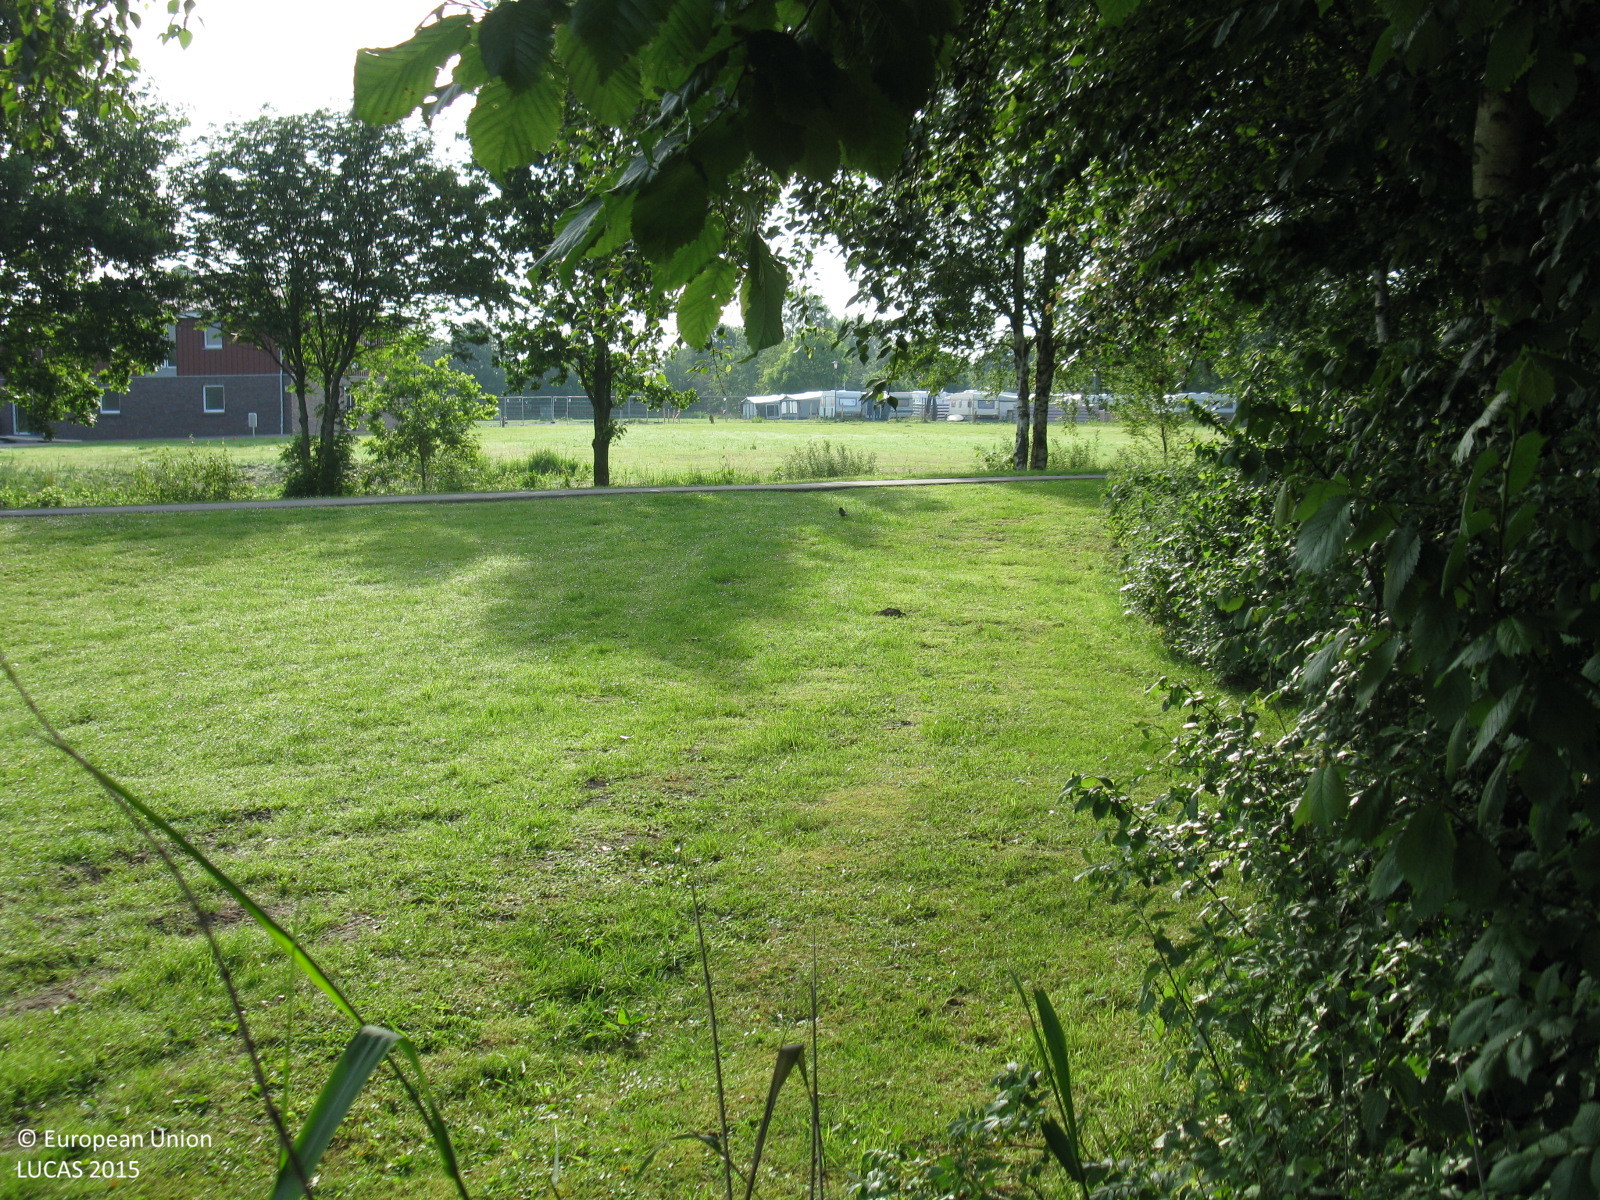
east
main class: Woodland
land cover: Broadleaved woodland
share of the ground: > 75 %
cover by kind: broadleaved forest trees 100 %
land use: Commerce
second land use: Amenities, museums, leisure
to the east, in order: Broadleaved woodland; Grassland without tree/shrub cover; Paved roads, cycling and walking lanes; Grassland without tree/shrub cover; Lines of trees; Ditches and canals; Shrubland without tree cover; Grassland without tree/shrub cover; Fences; Tracks; Grassland without tree/shrub cover; Ditches and canals; Shruby margins; Artificial constructions in urban areas; Broadleaved woodland; Ditches and canals; Grassland without tree/shrub cover
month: June
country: DE
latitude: 53.4439
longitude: 7.3057
